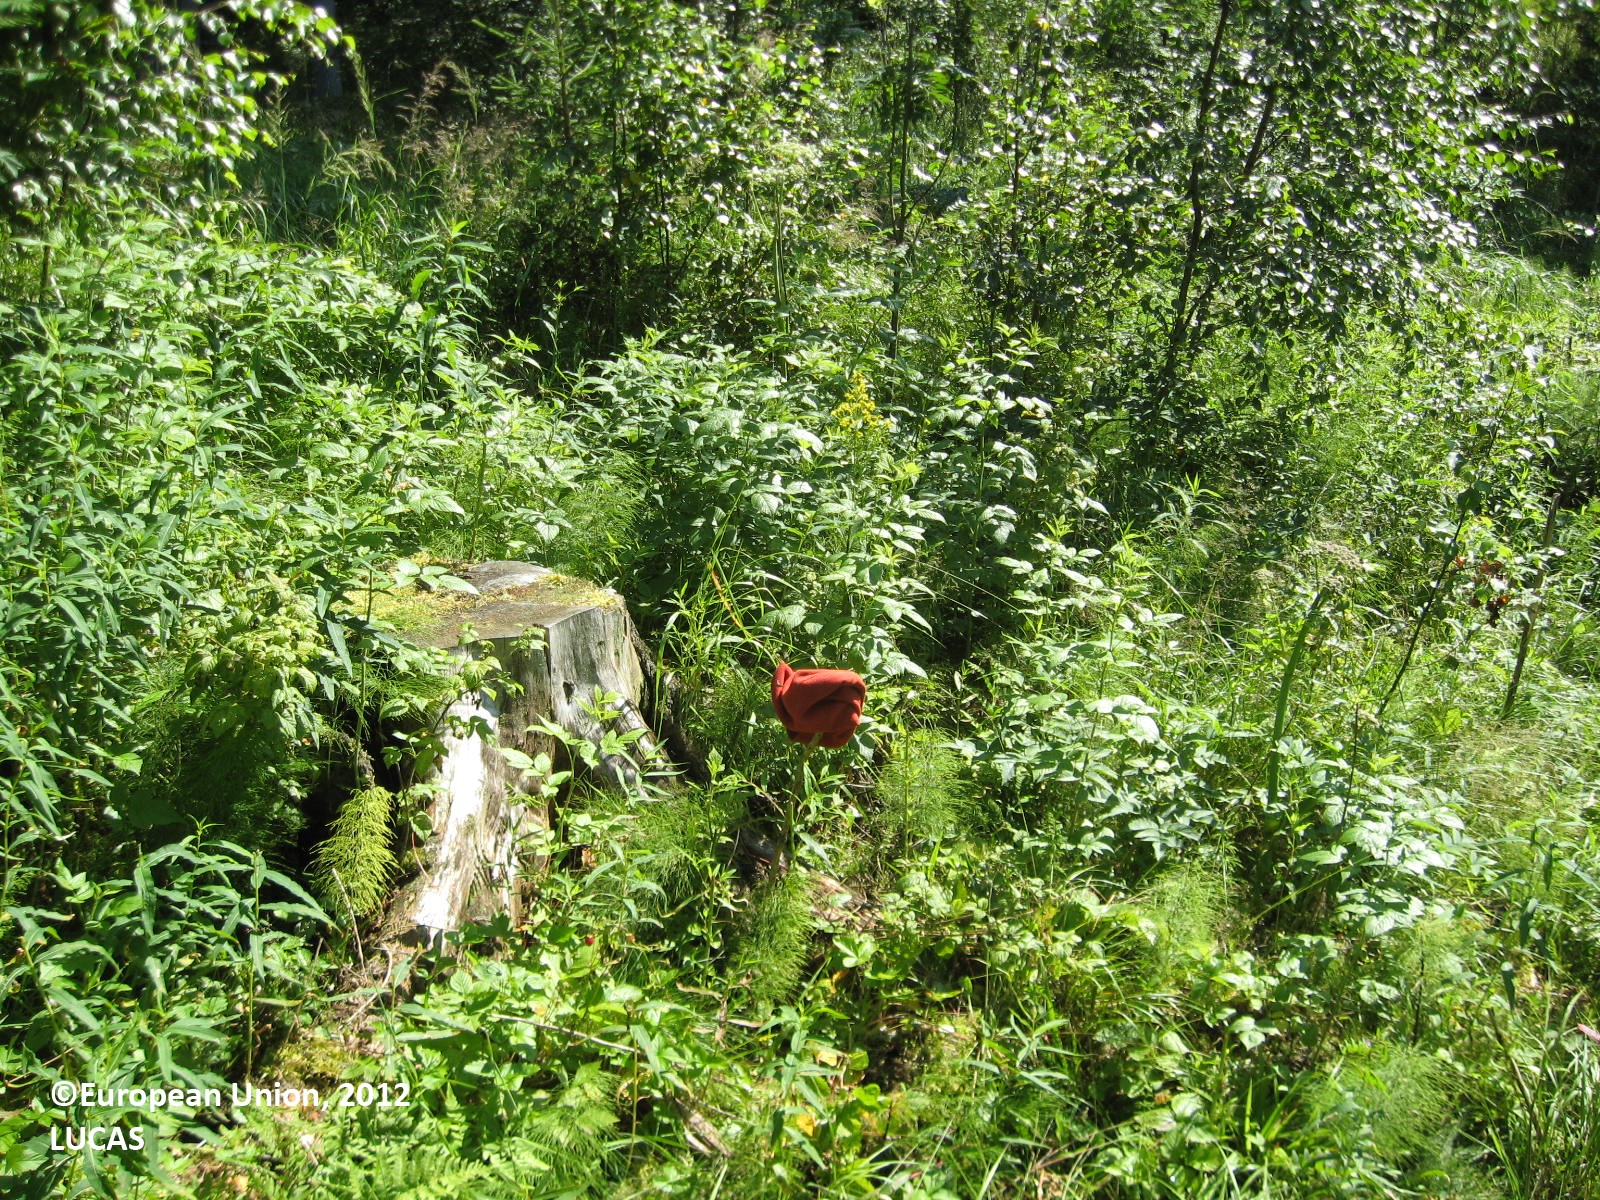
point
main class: Woodland
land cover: Other mixed woodland
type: boreal forest
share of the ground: > 75 %
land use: Forestry
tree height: > 5 m
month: July
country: FI
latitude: 61.9277
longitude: 22.8857
